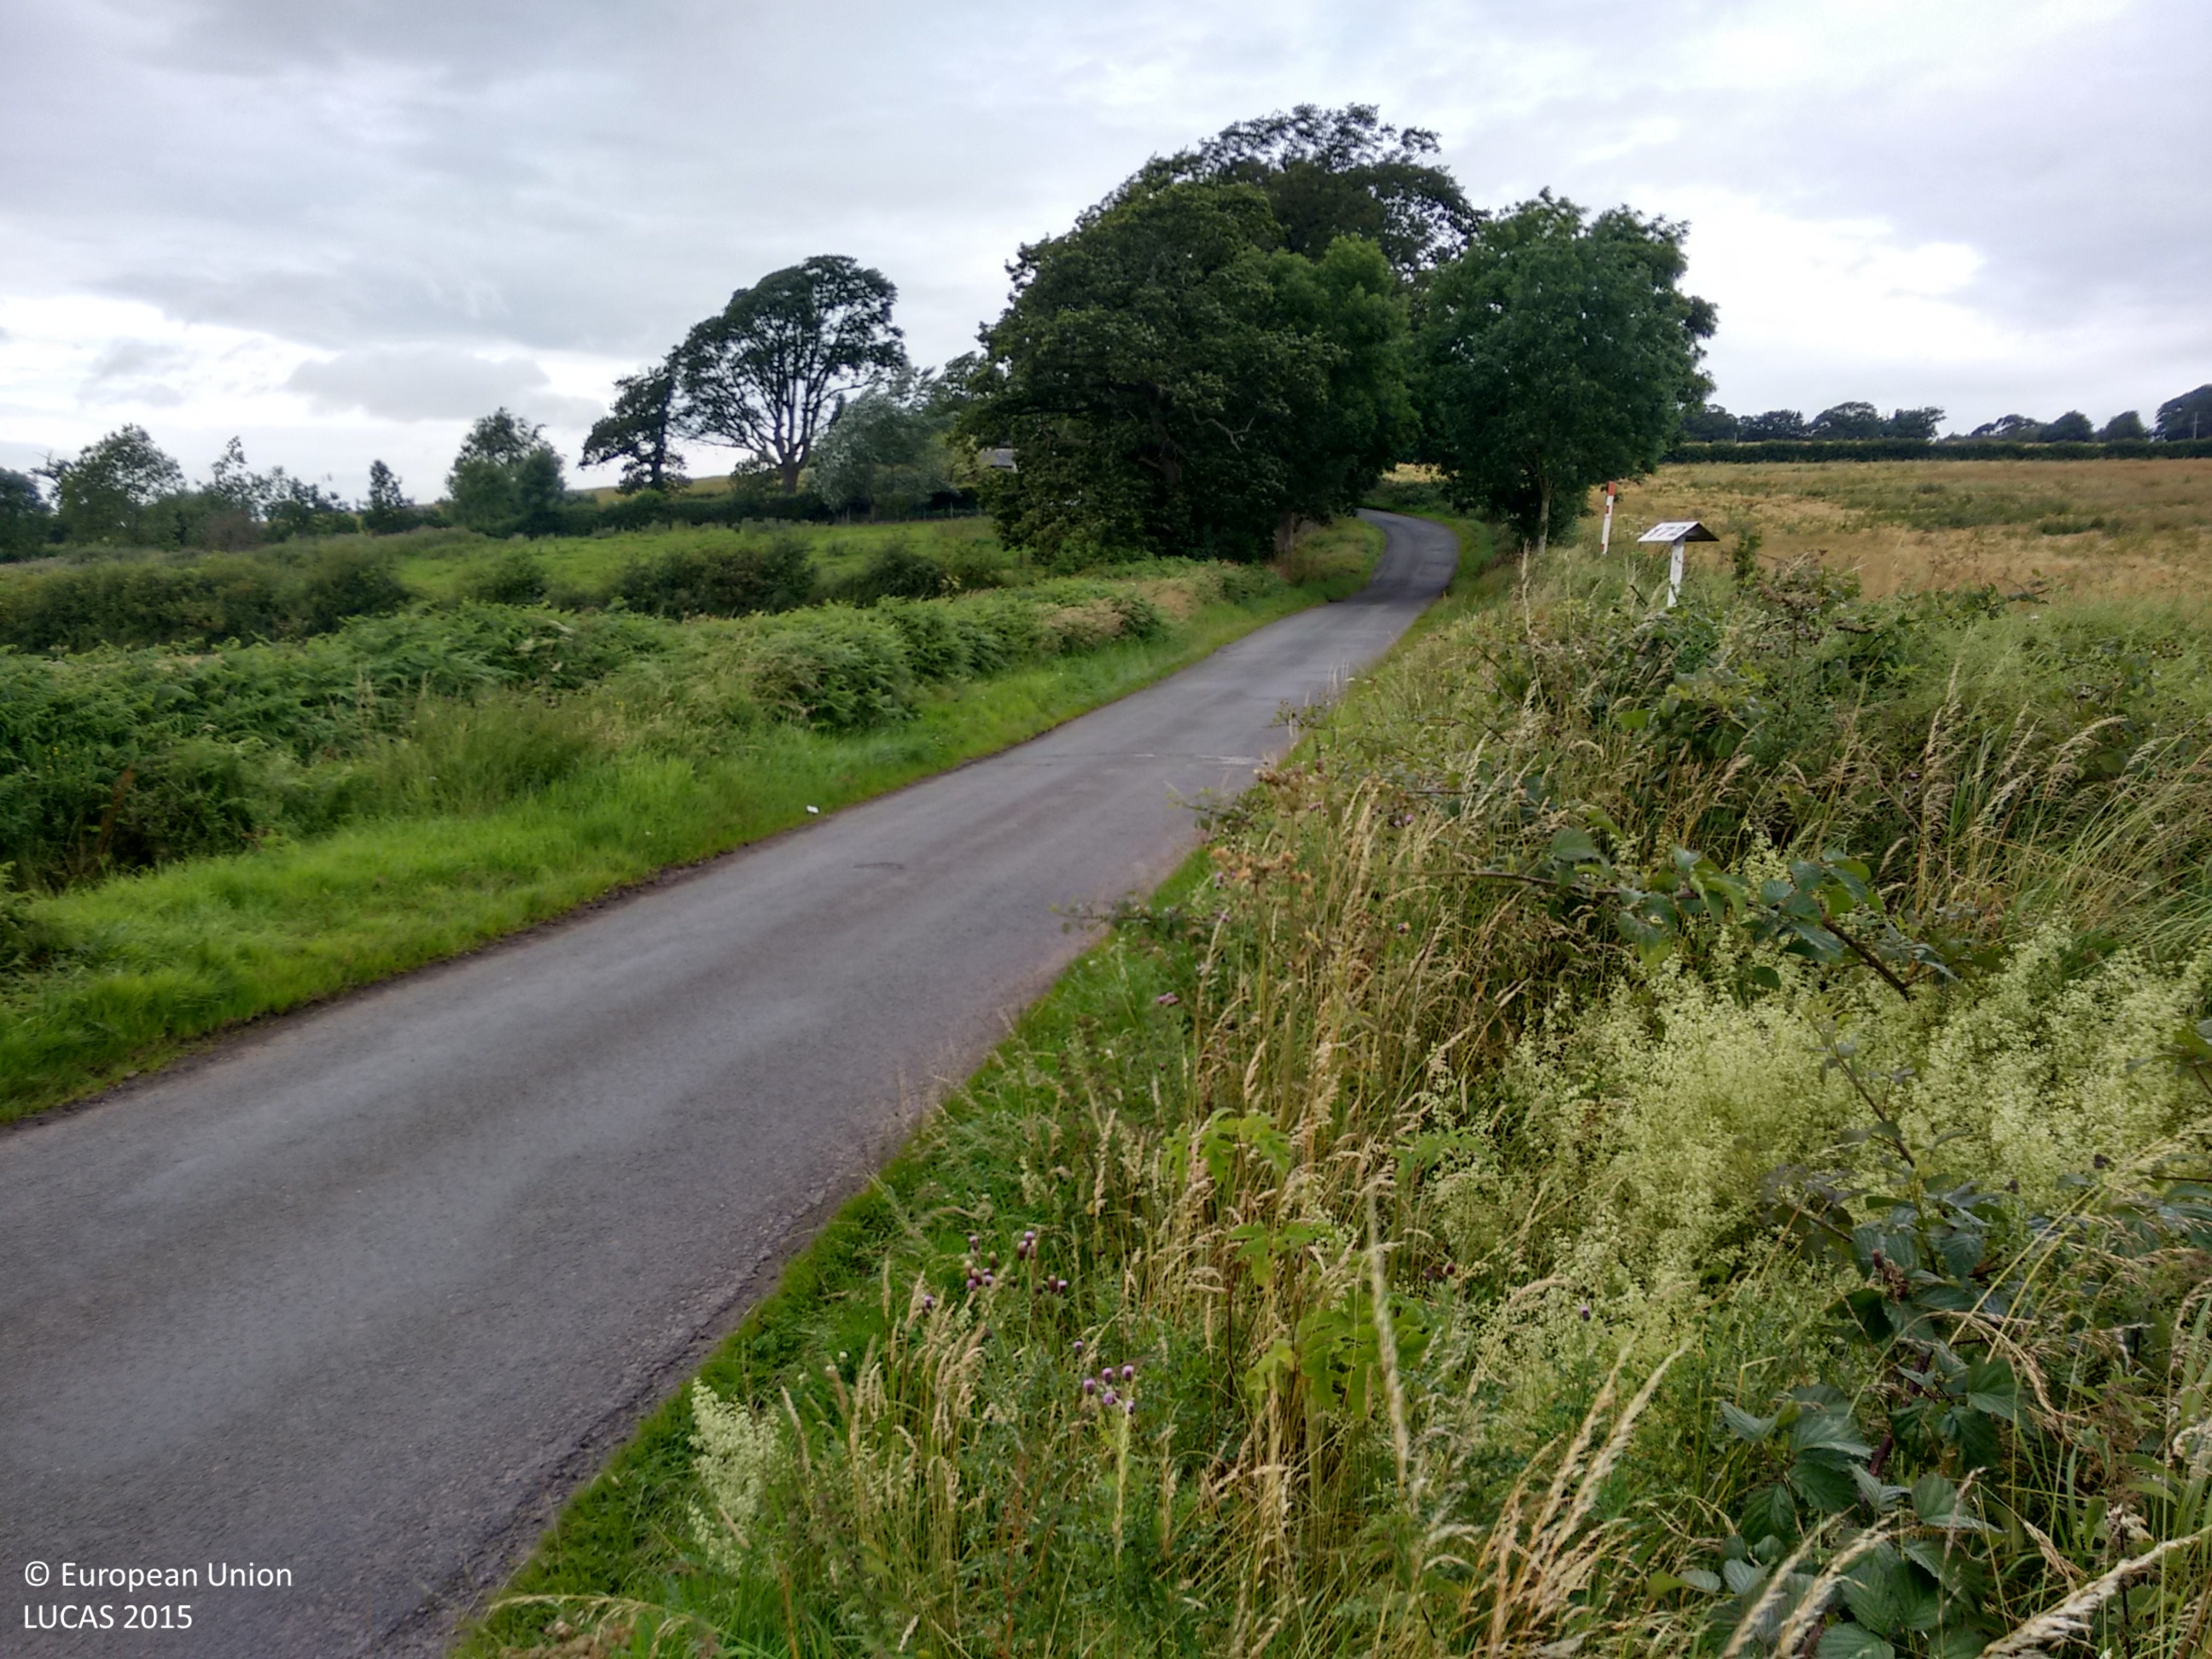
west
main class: Cropland
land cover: Rape and turnip rape
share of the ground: > 75 %
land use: Agriculture (excluding fallow land and kitchen gardens)
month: August
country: GB
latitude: 54.8130
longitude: -2.8125
